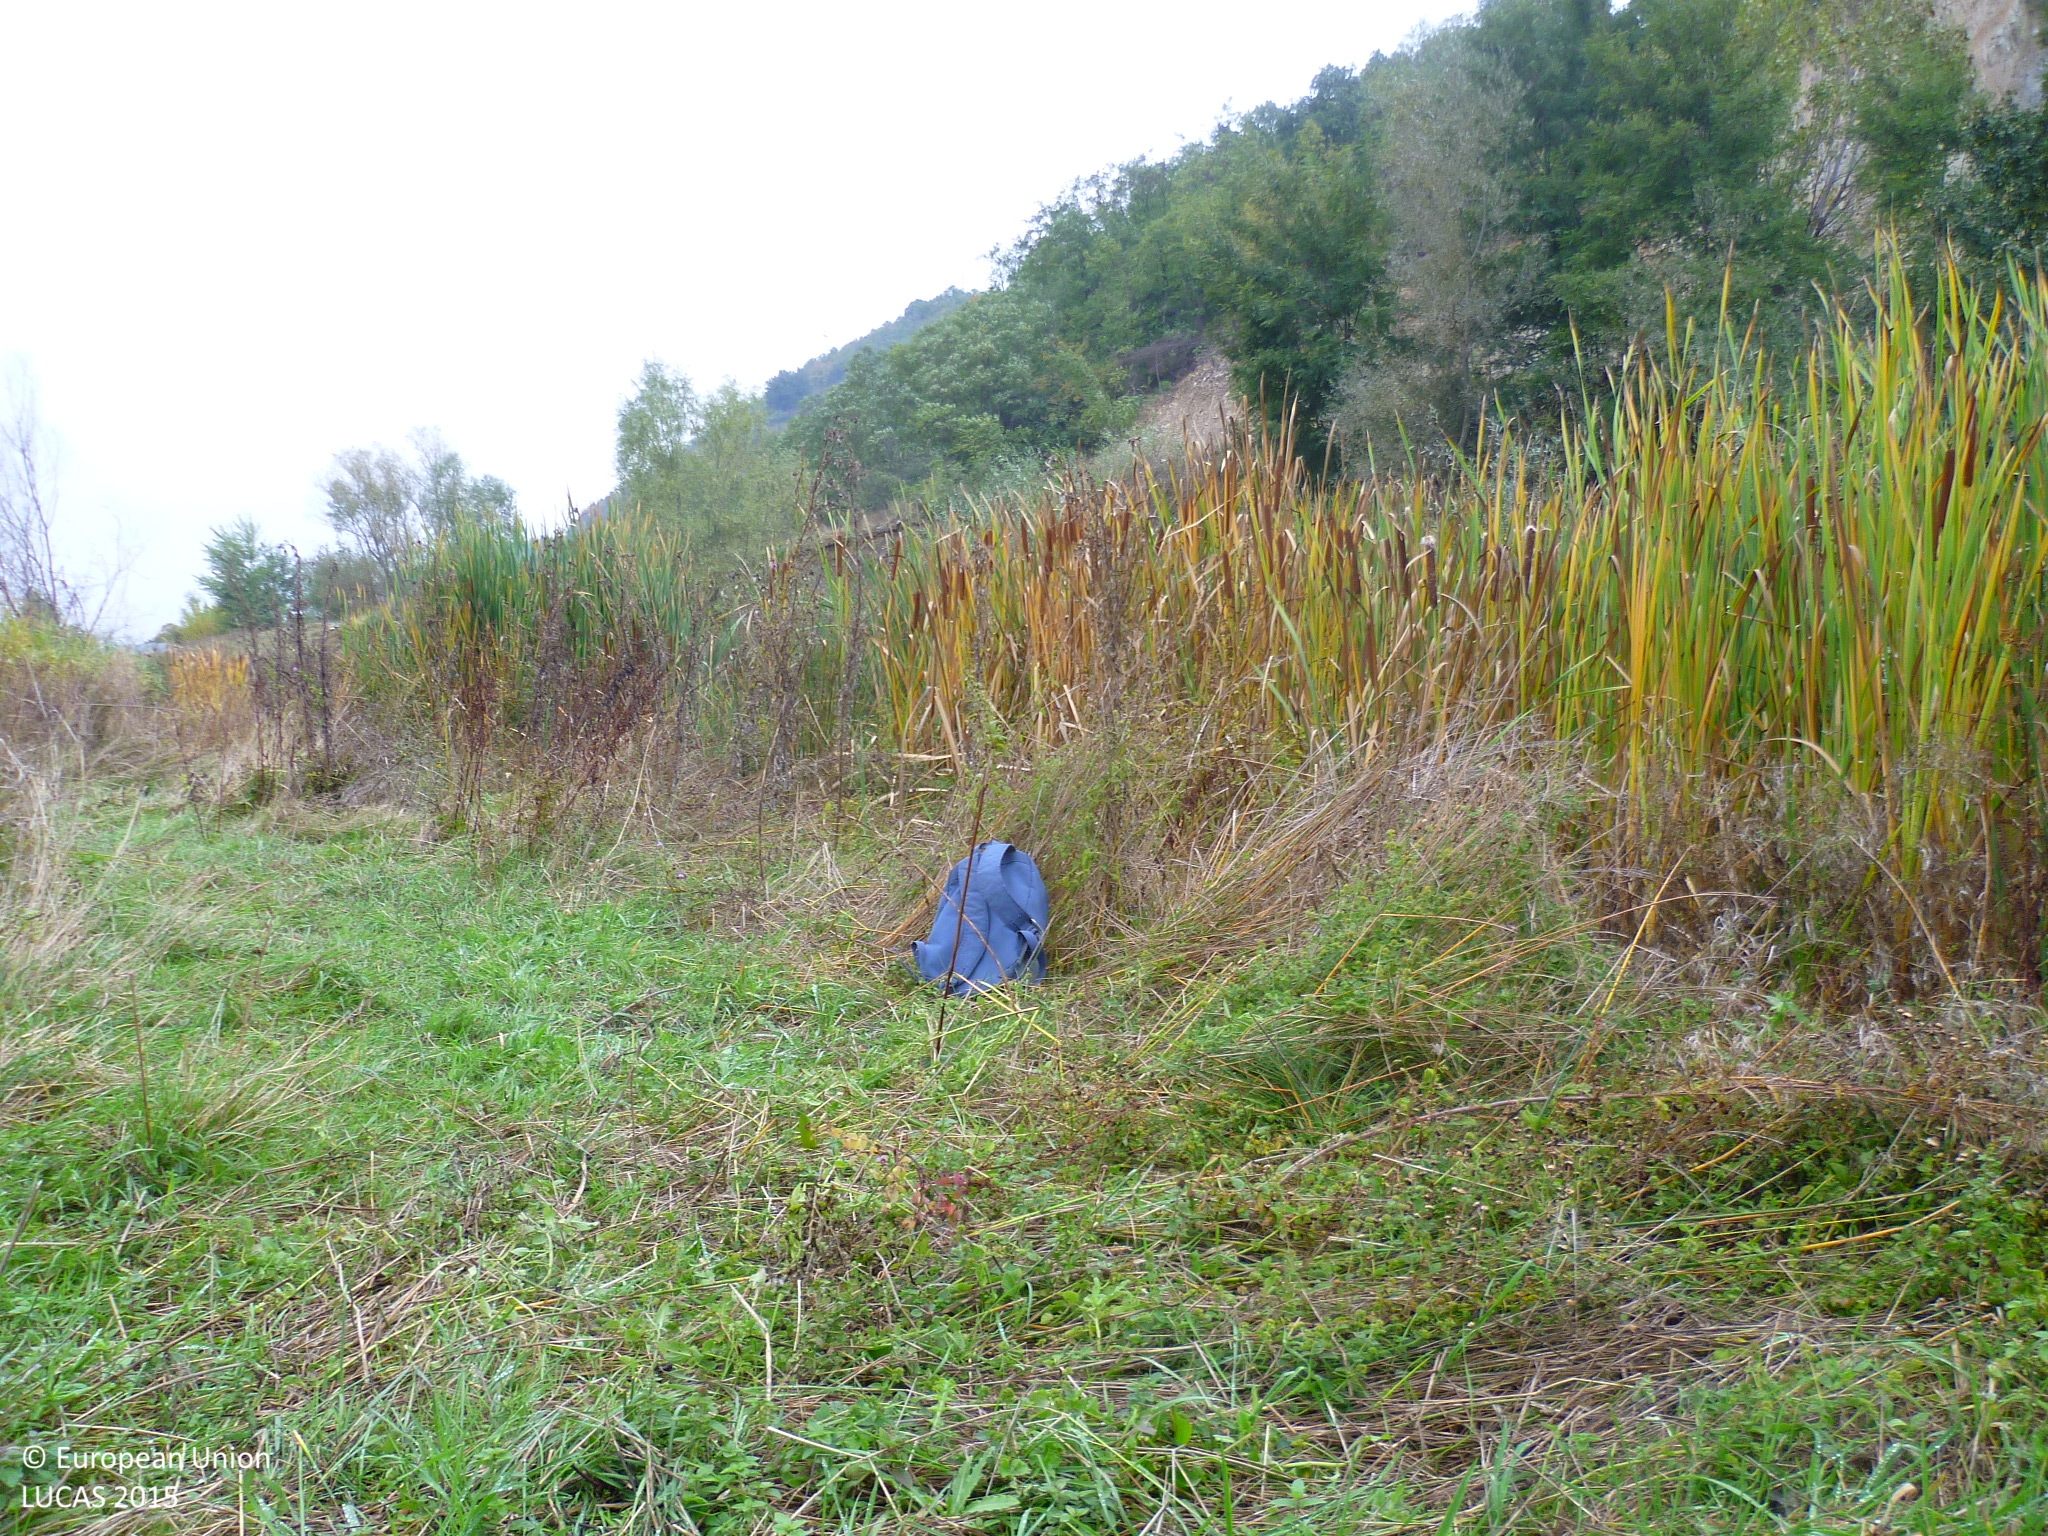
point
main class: Grassland
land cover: Spontaneously vegetated surfaces
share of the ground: > 75 %
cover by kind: herbaceous plants 100 %
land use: Semi-natural and natural areas not in use
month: October
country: BG
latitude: 42.3182
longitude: 23.8584
